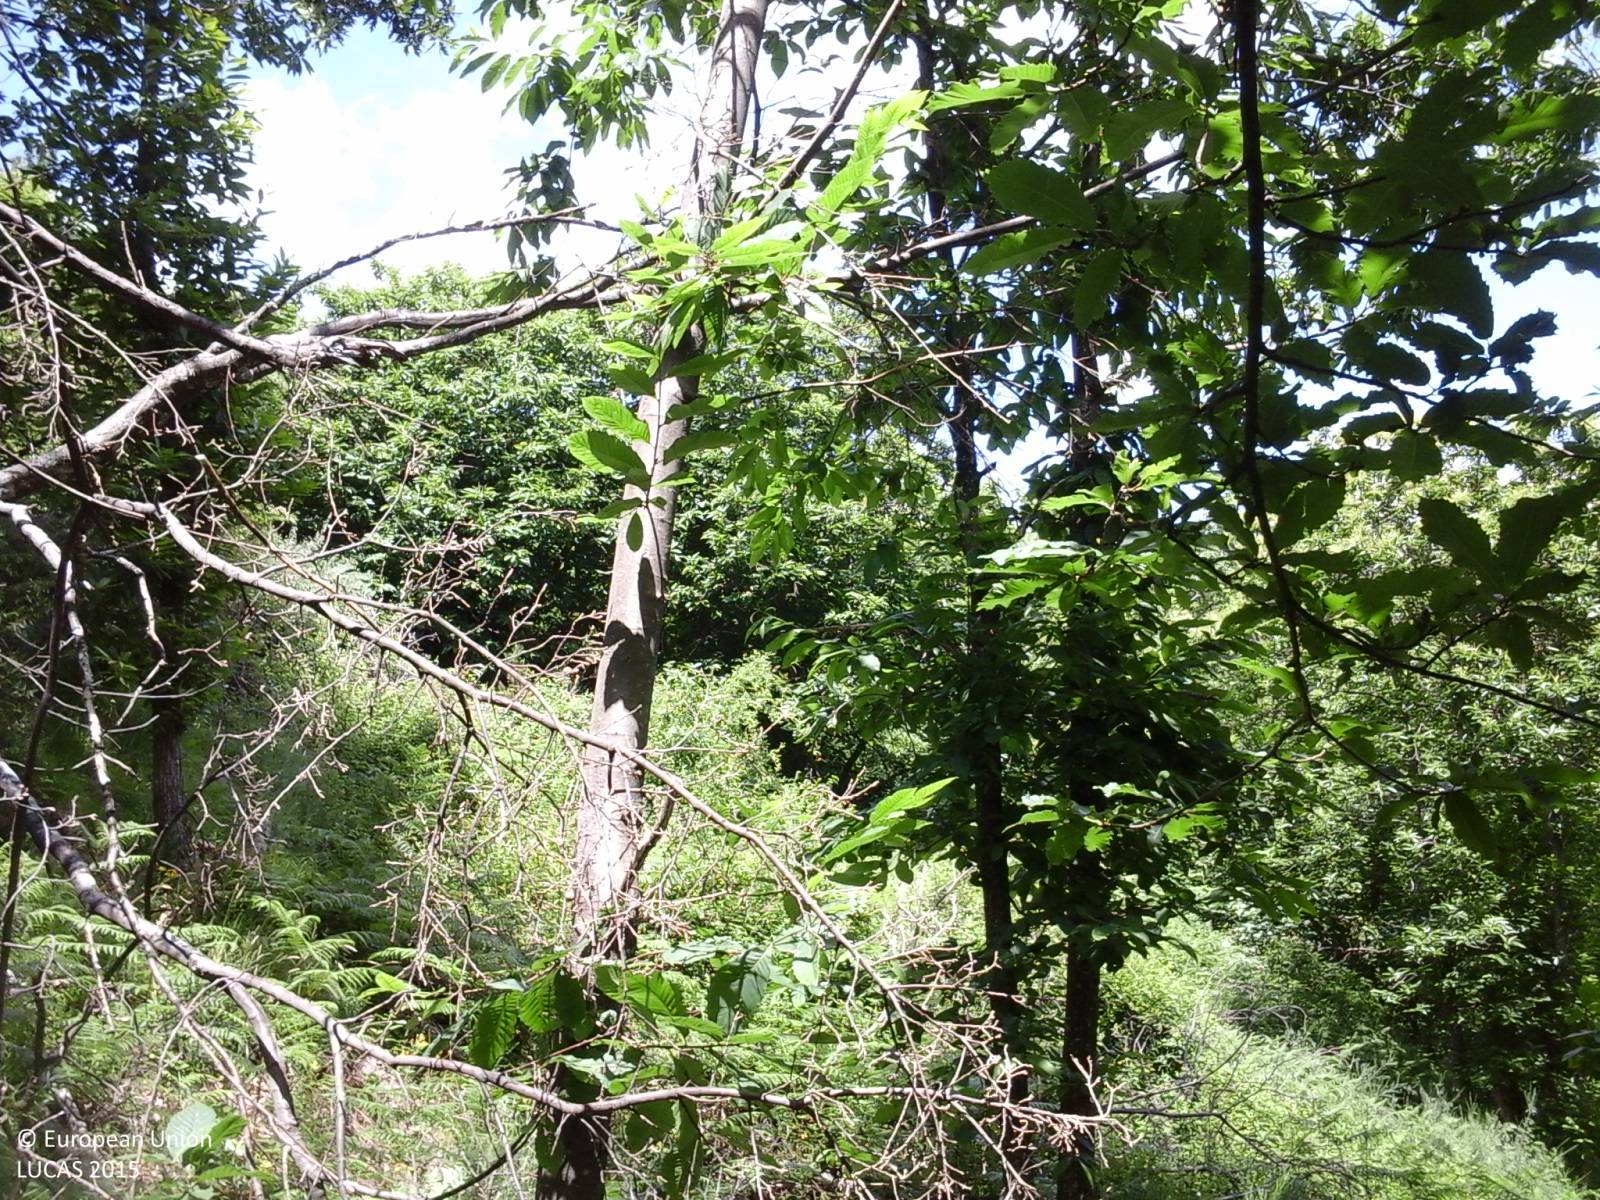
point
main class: Woodland
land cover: Broadleaved woodland
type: thermophilous deciduous forest
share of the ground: > 75 %
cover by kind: broadleaved forest trees 100 %
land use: Forestry
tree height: > 5 m
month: June
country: IT
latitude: 44.1877
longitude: 10.3370
